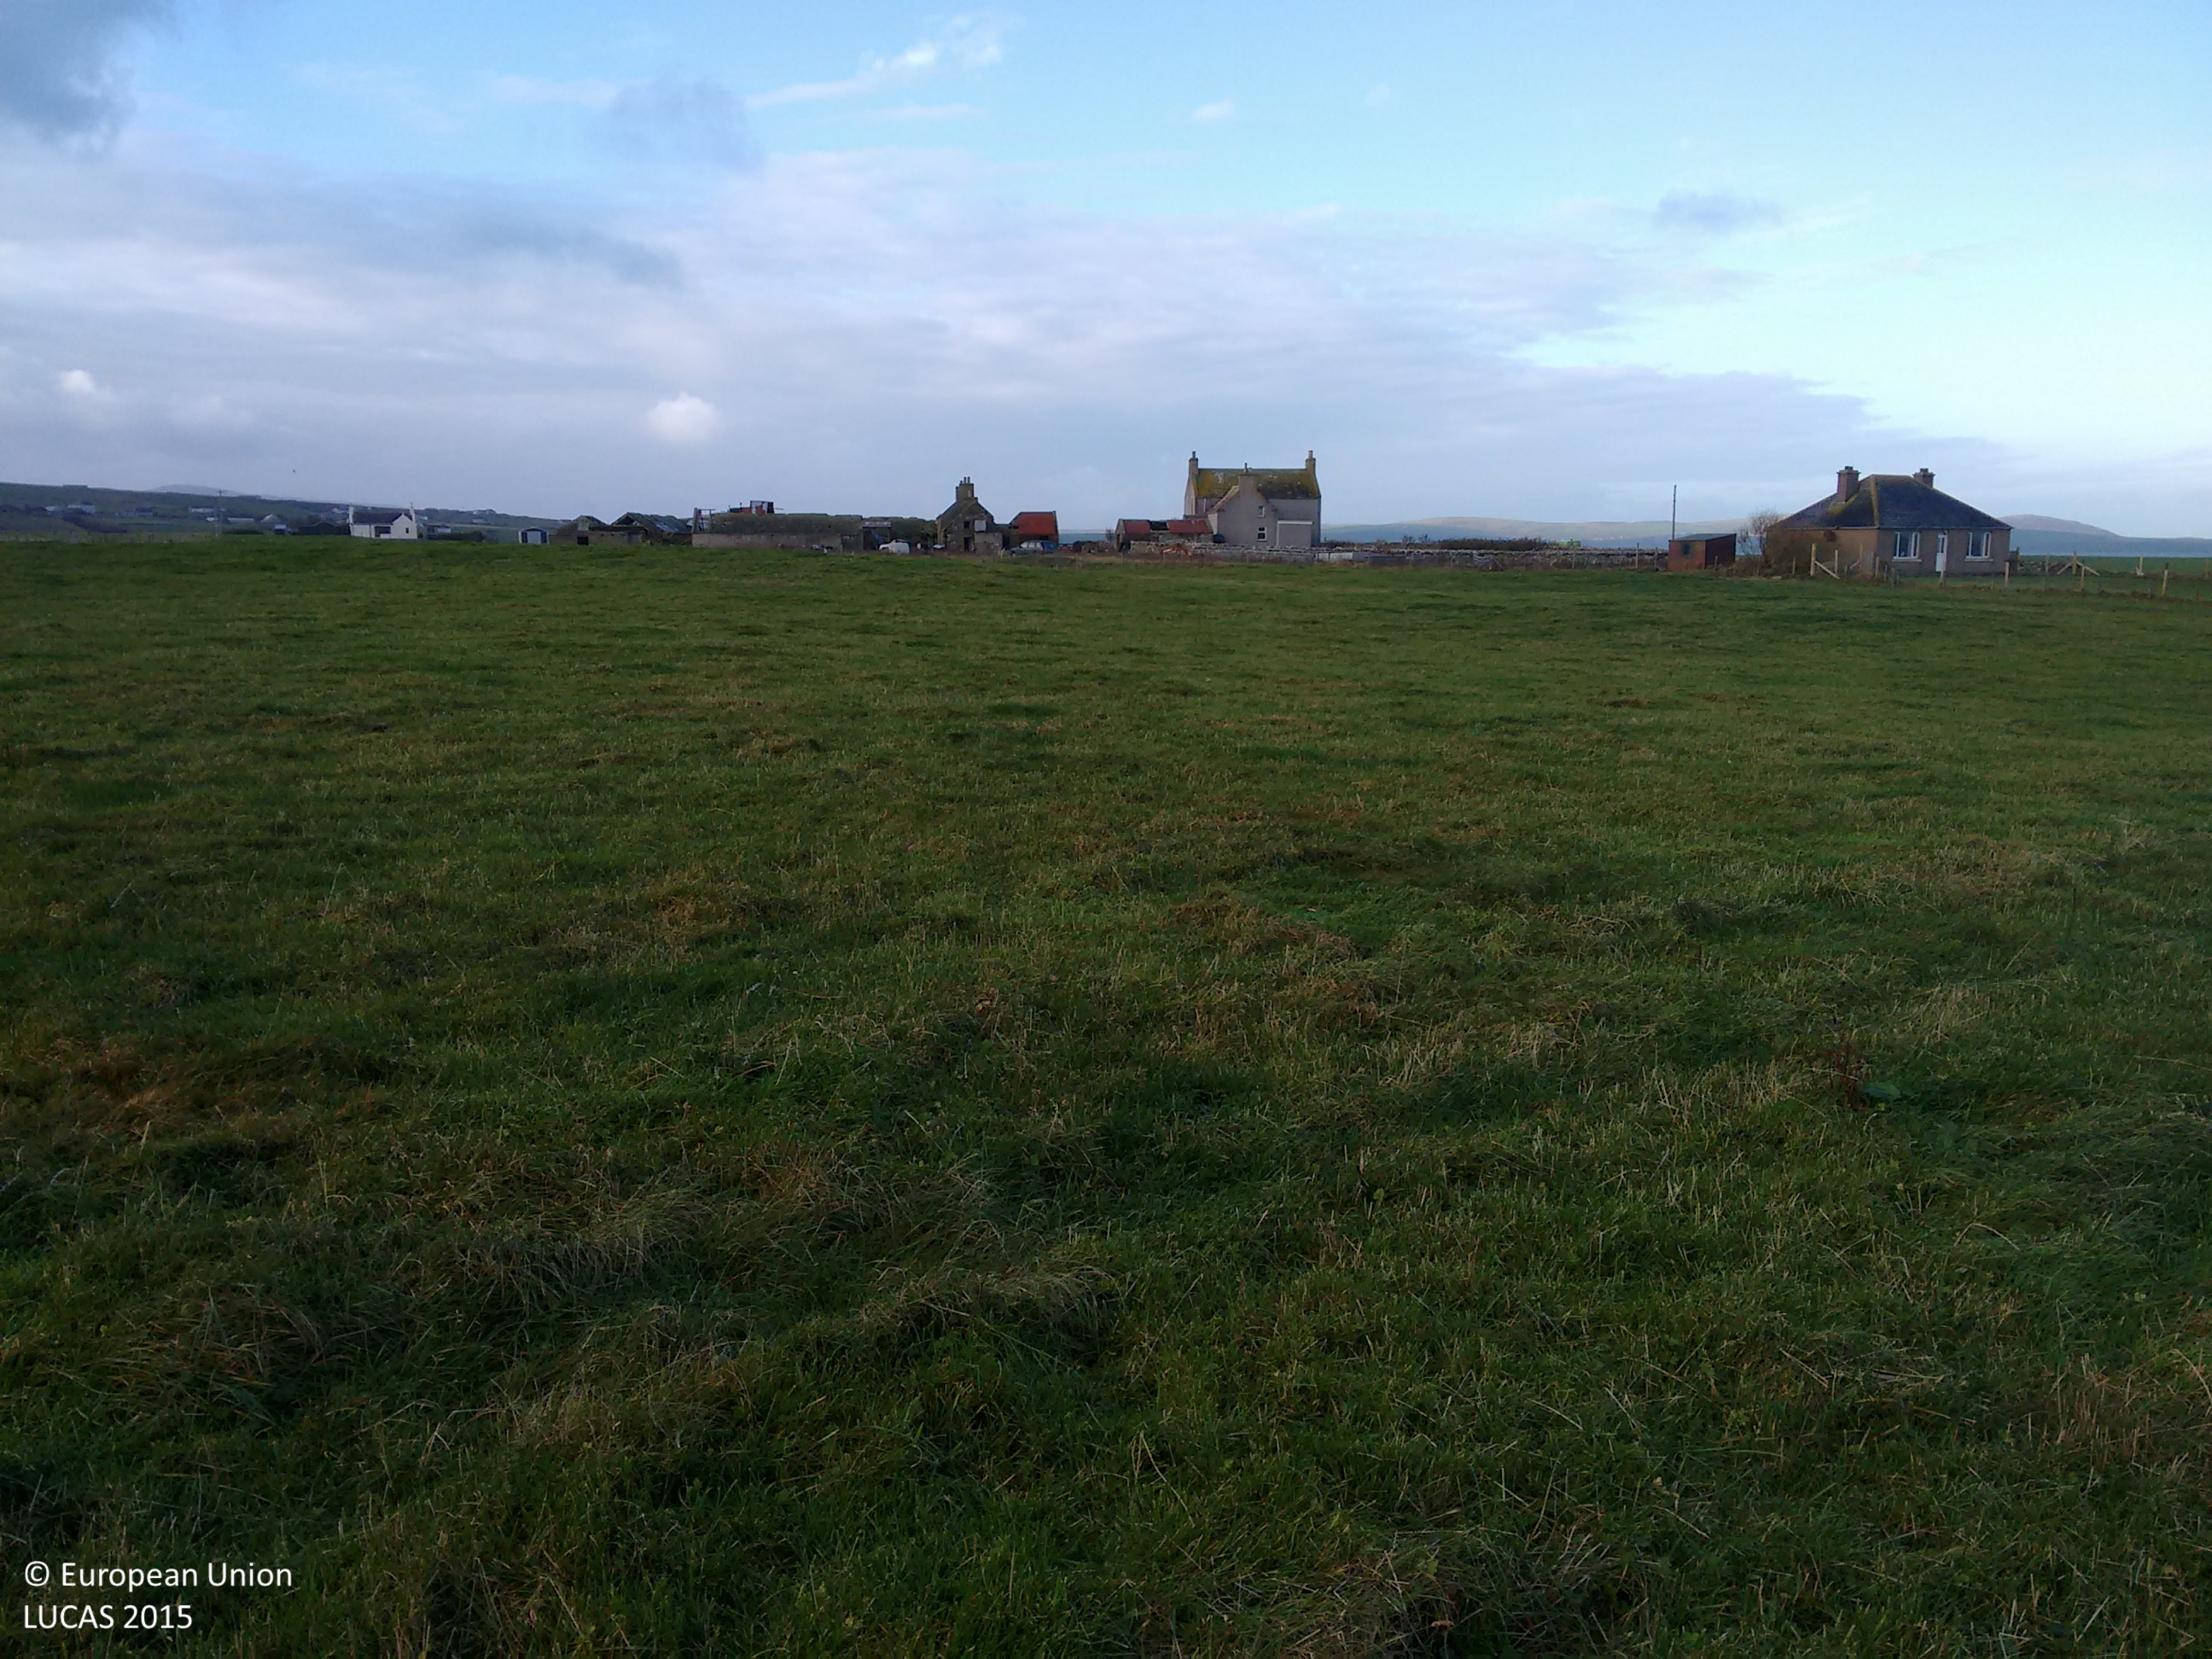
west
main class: Grassland
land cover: Grassland without tree/shrub cover
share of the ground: > 75 %
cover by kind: herbaceous plants 100 %
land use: Agriculture (excluding fallow land and kitchen gardens)
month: November
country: GB
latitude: 58.9903
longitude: -3.1948
